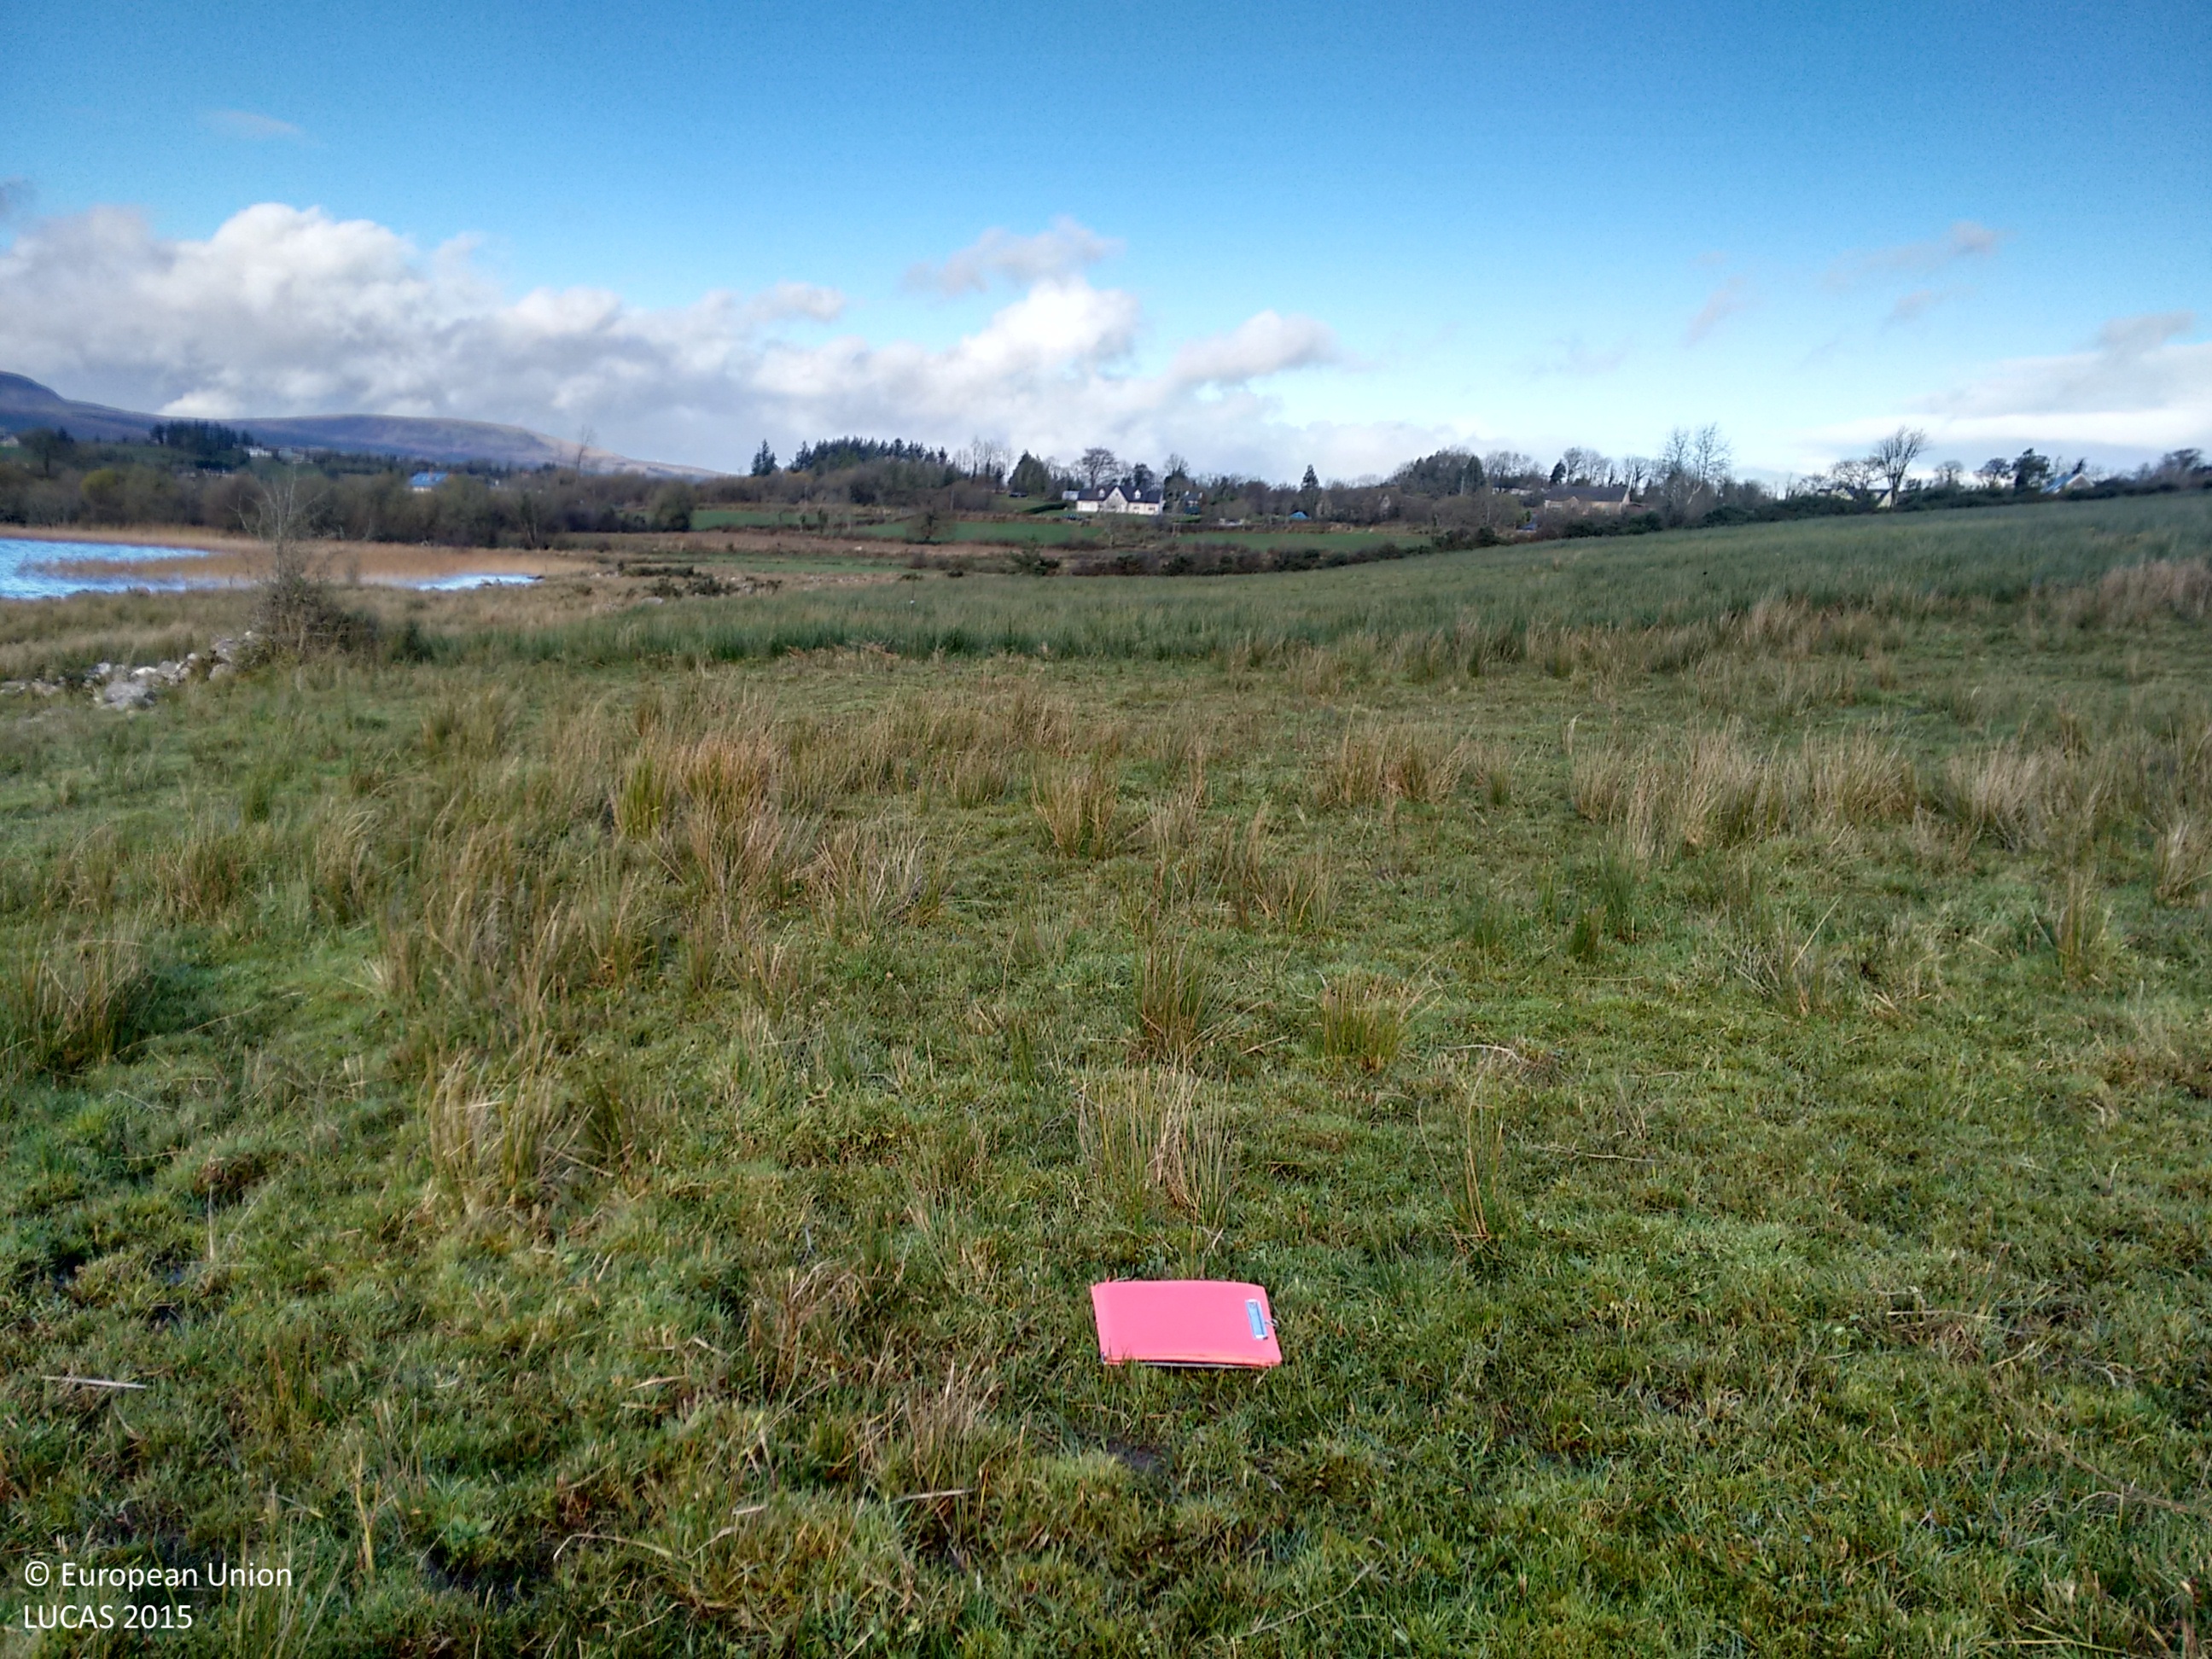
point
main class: Grassland
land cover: Grassland without tree/shrub cover
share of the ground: > 75 %
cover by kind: herbaceous plants 100 %
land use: Agriculture (excluding fallow land and kitchen gardens)
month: November
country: IE
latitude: 54.0445
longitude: -7.9014
